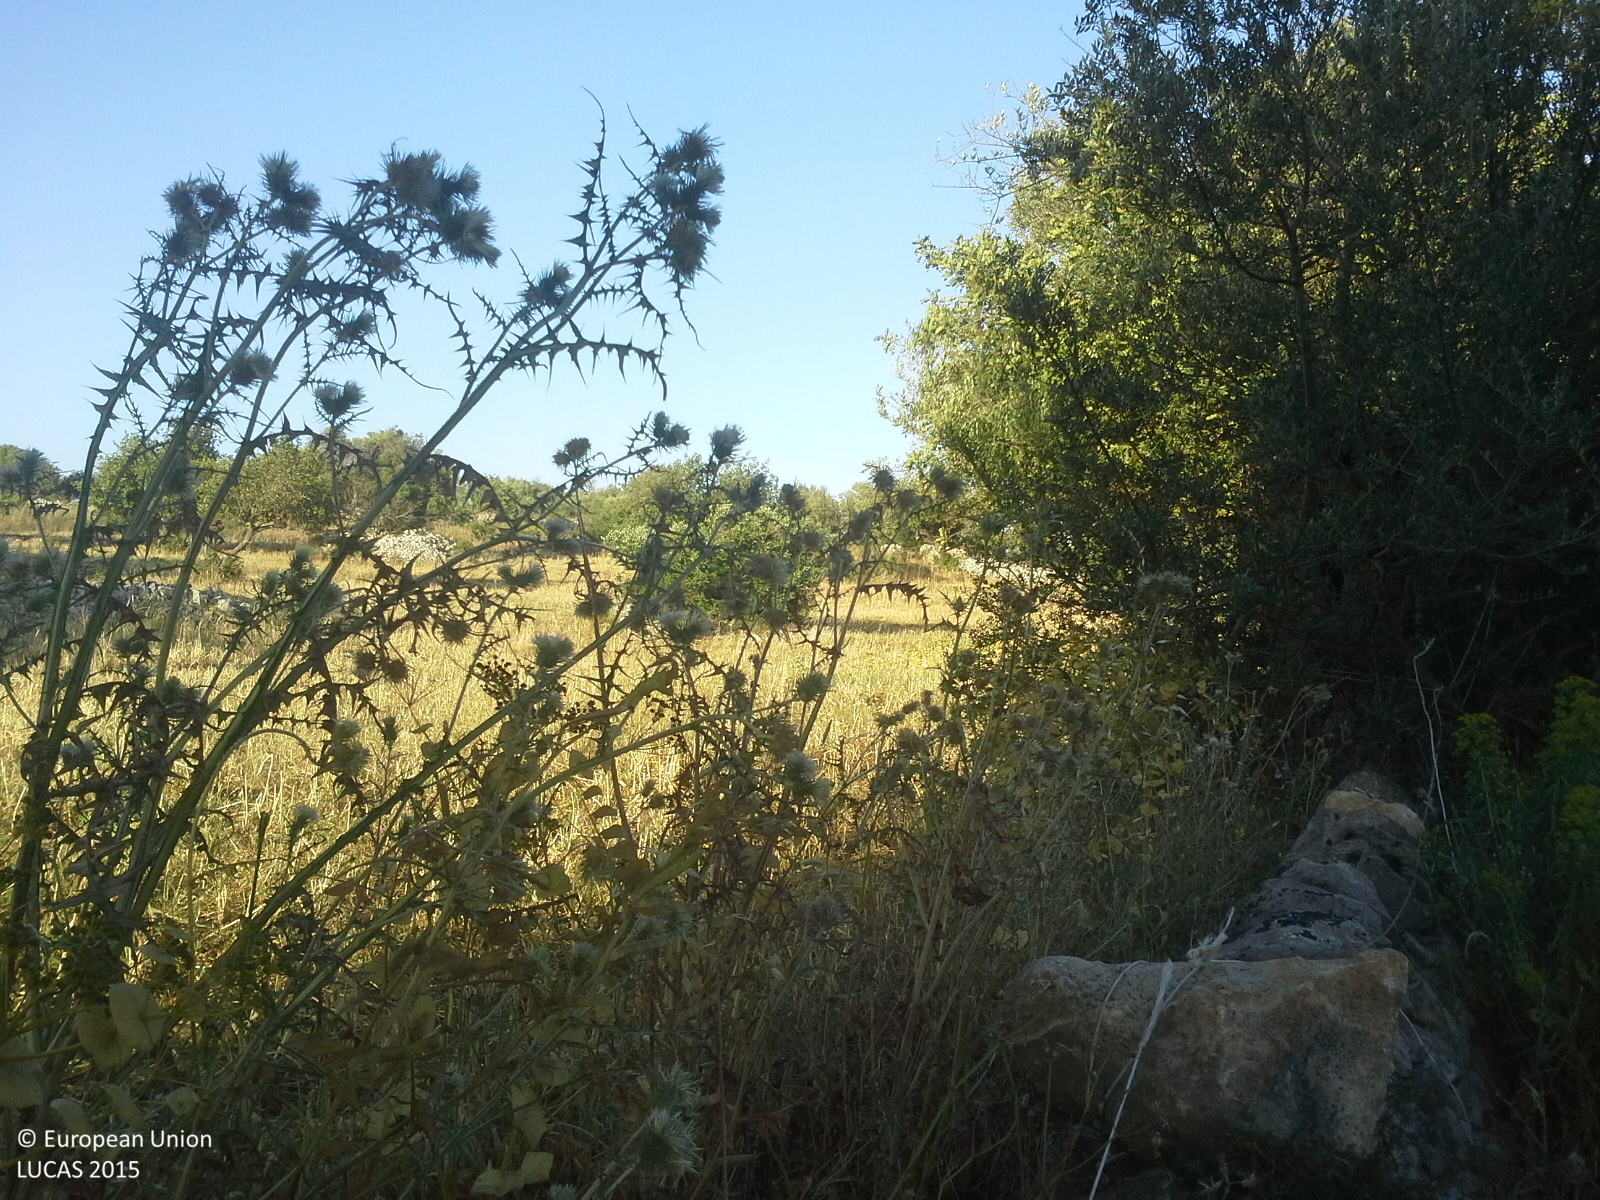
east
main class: Cropland
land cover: Permanent industrial crops
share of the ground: > 75 %
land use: Agriculture (excluding fallow land and kitchen gardens)
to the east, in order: Permanent industrial crops; Spontaneously vegetated surfaces; Shruby margins; Dry stone walls; Fences; Shrubland with sparse tree cover; Dry stone walls; Rocks and stones; Grassland with sparse tree/shrub cover; Dry stone walls; Grassland with sparse tree/shrub cover; Electric lines; Grassland with sparse tree/shrub cover
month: May
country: IT
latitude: 36.7866
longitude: 14.8578
